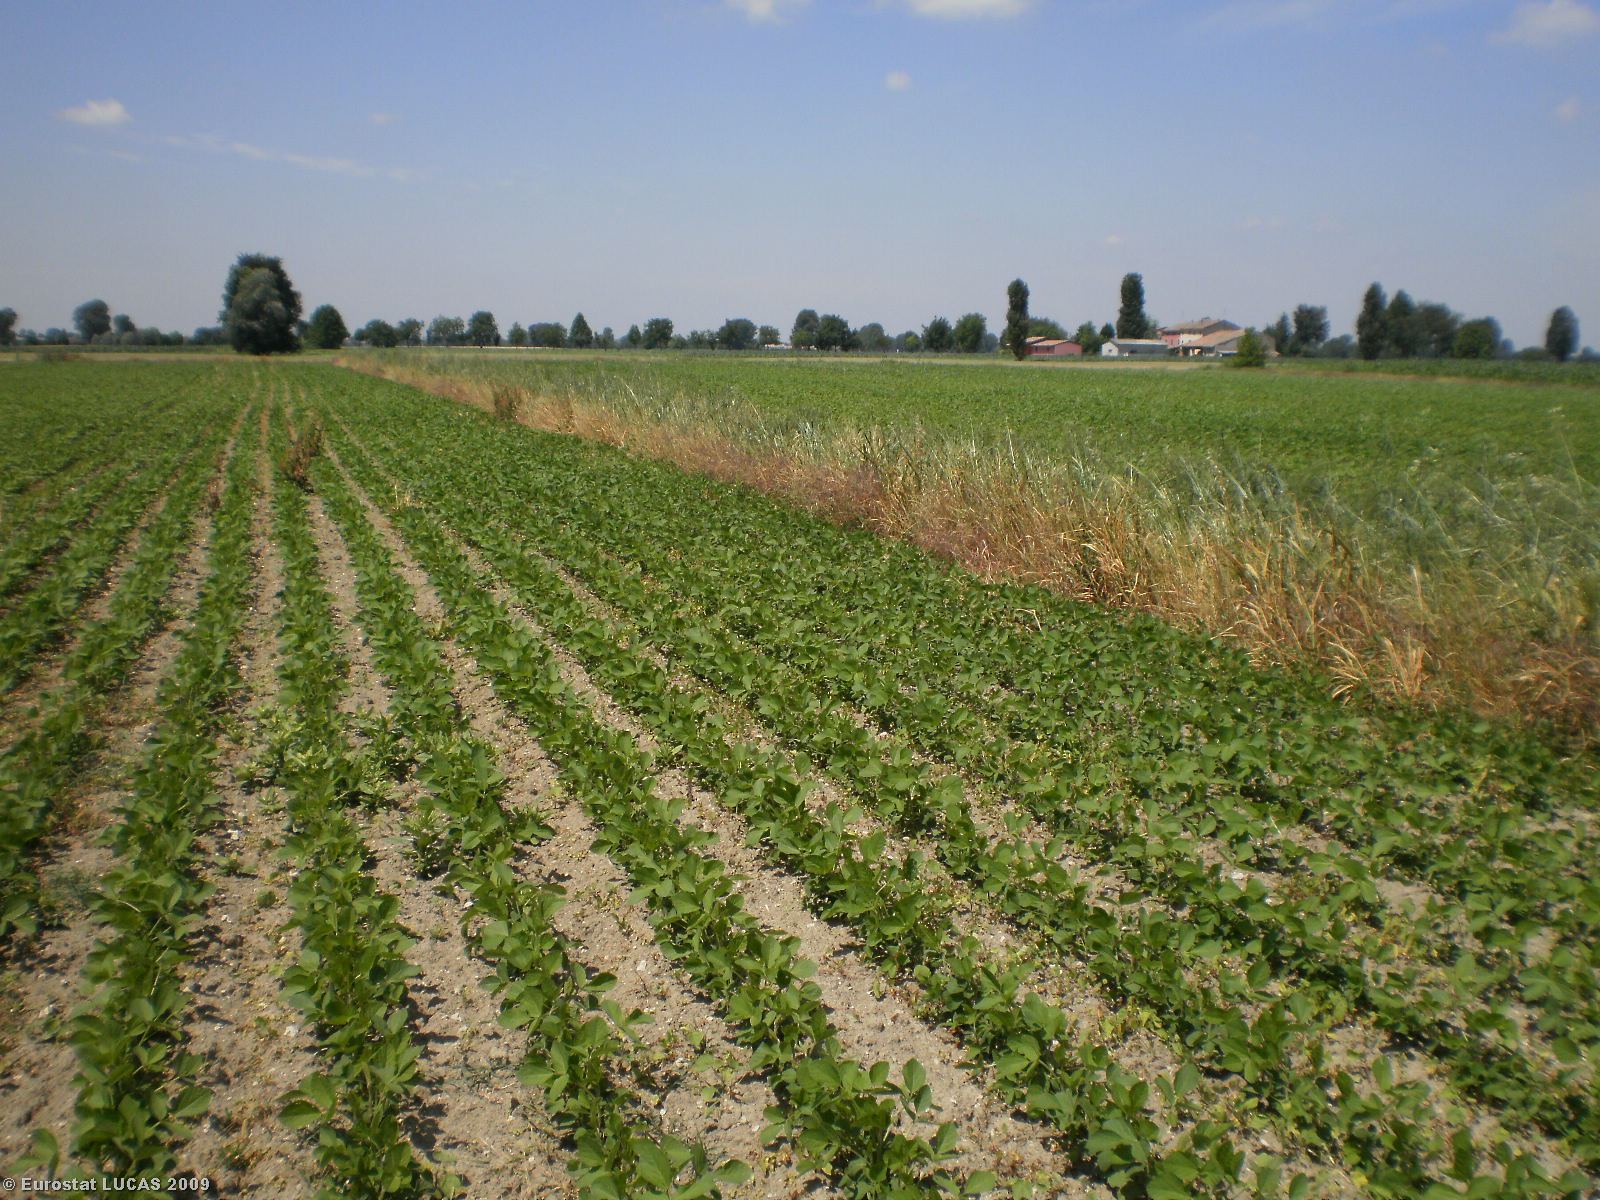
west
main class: Cropland
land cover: Soya
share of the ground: 50 - 75 %
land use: Agriculture (excluding fallow land and kitchen gardens)
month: May
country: IT
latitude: 45.2692
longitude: 10.4453
